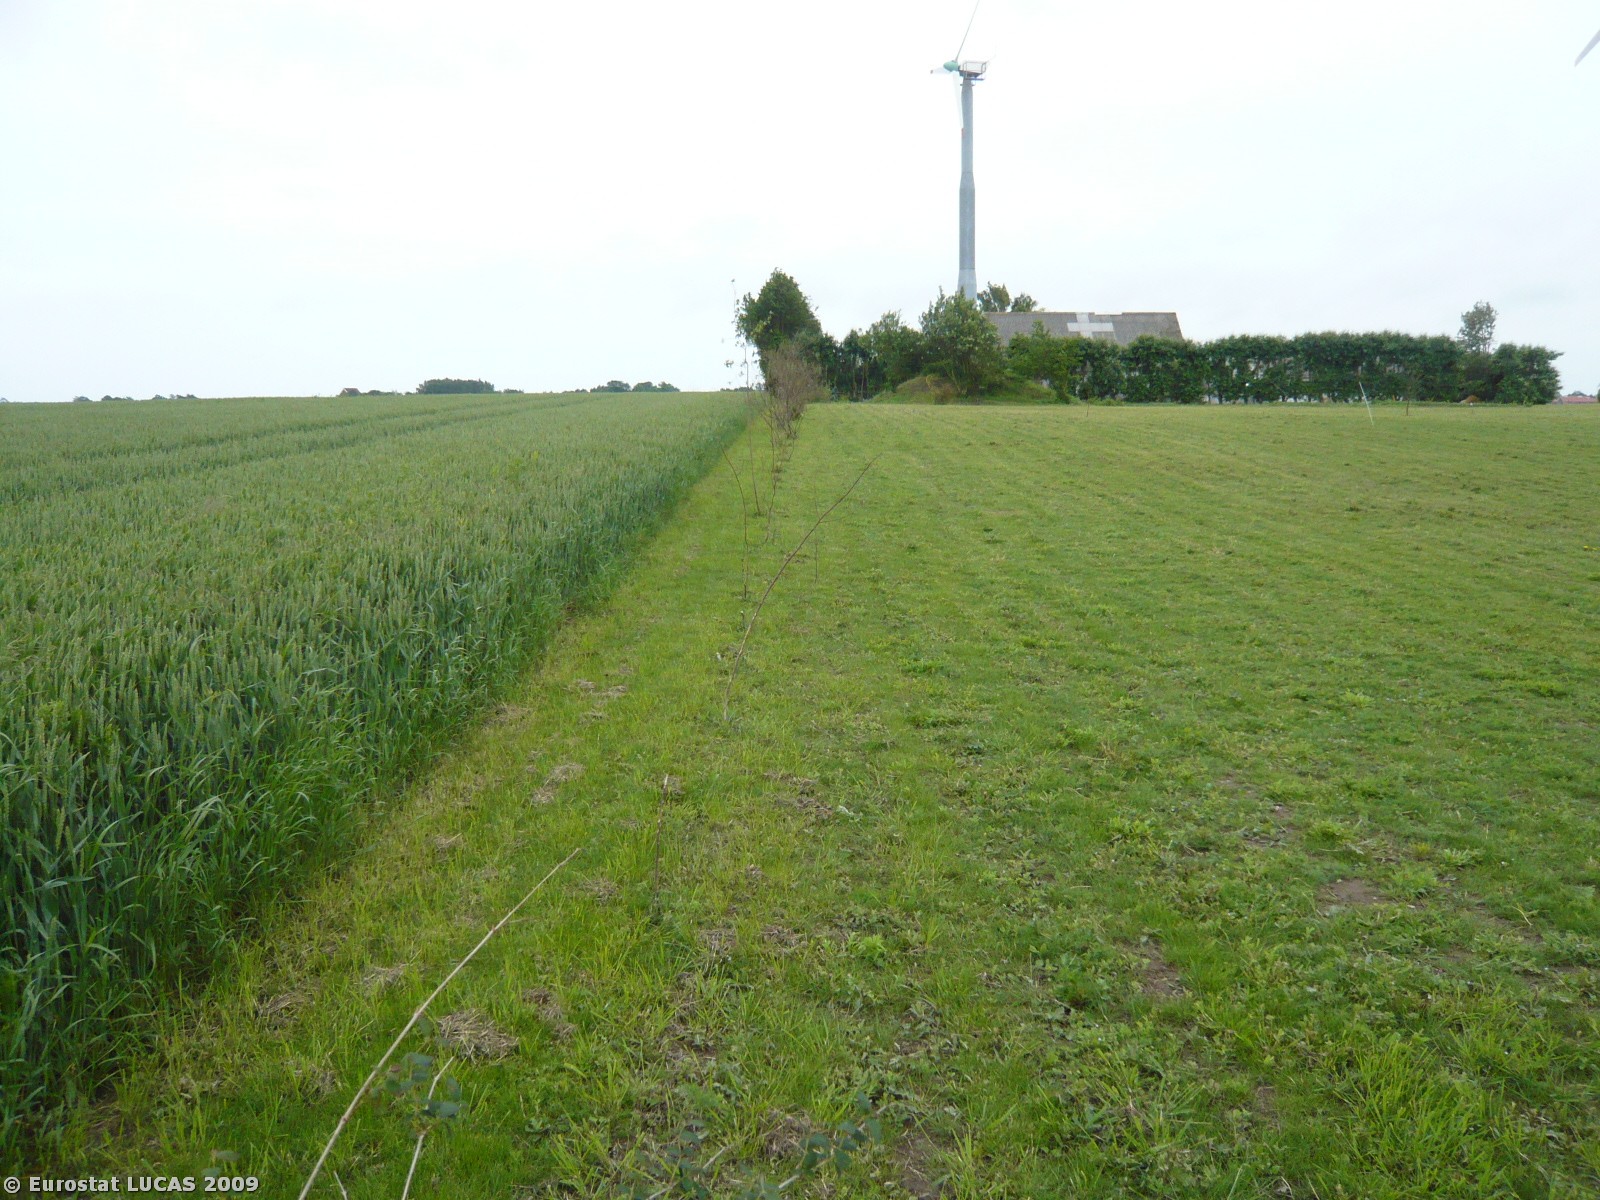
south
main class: Grassland
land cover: Grassland with sparse tree/shrub cover
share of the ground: > 75 %
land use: Residential
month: June
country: DK
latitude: 54.7522
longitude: 11.9720
